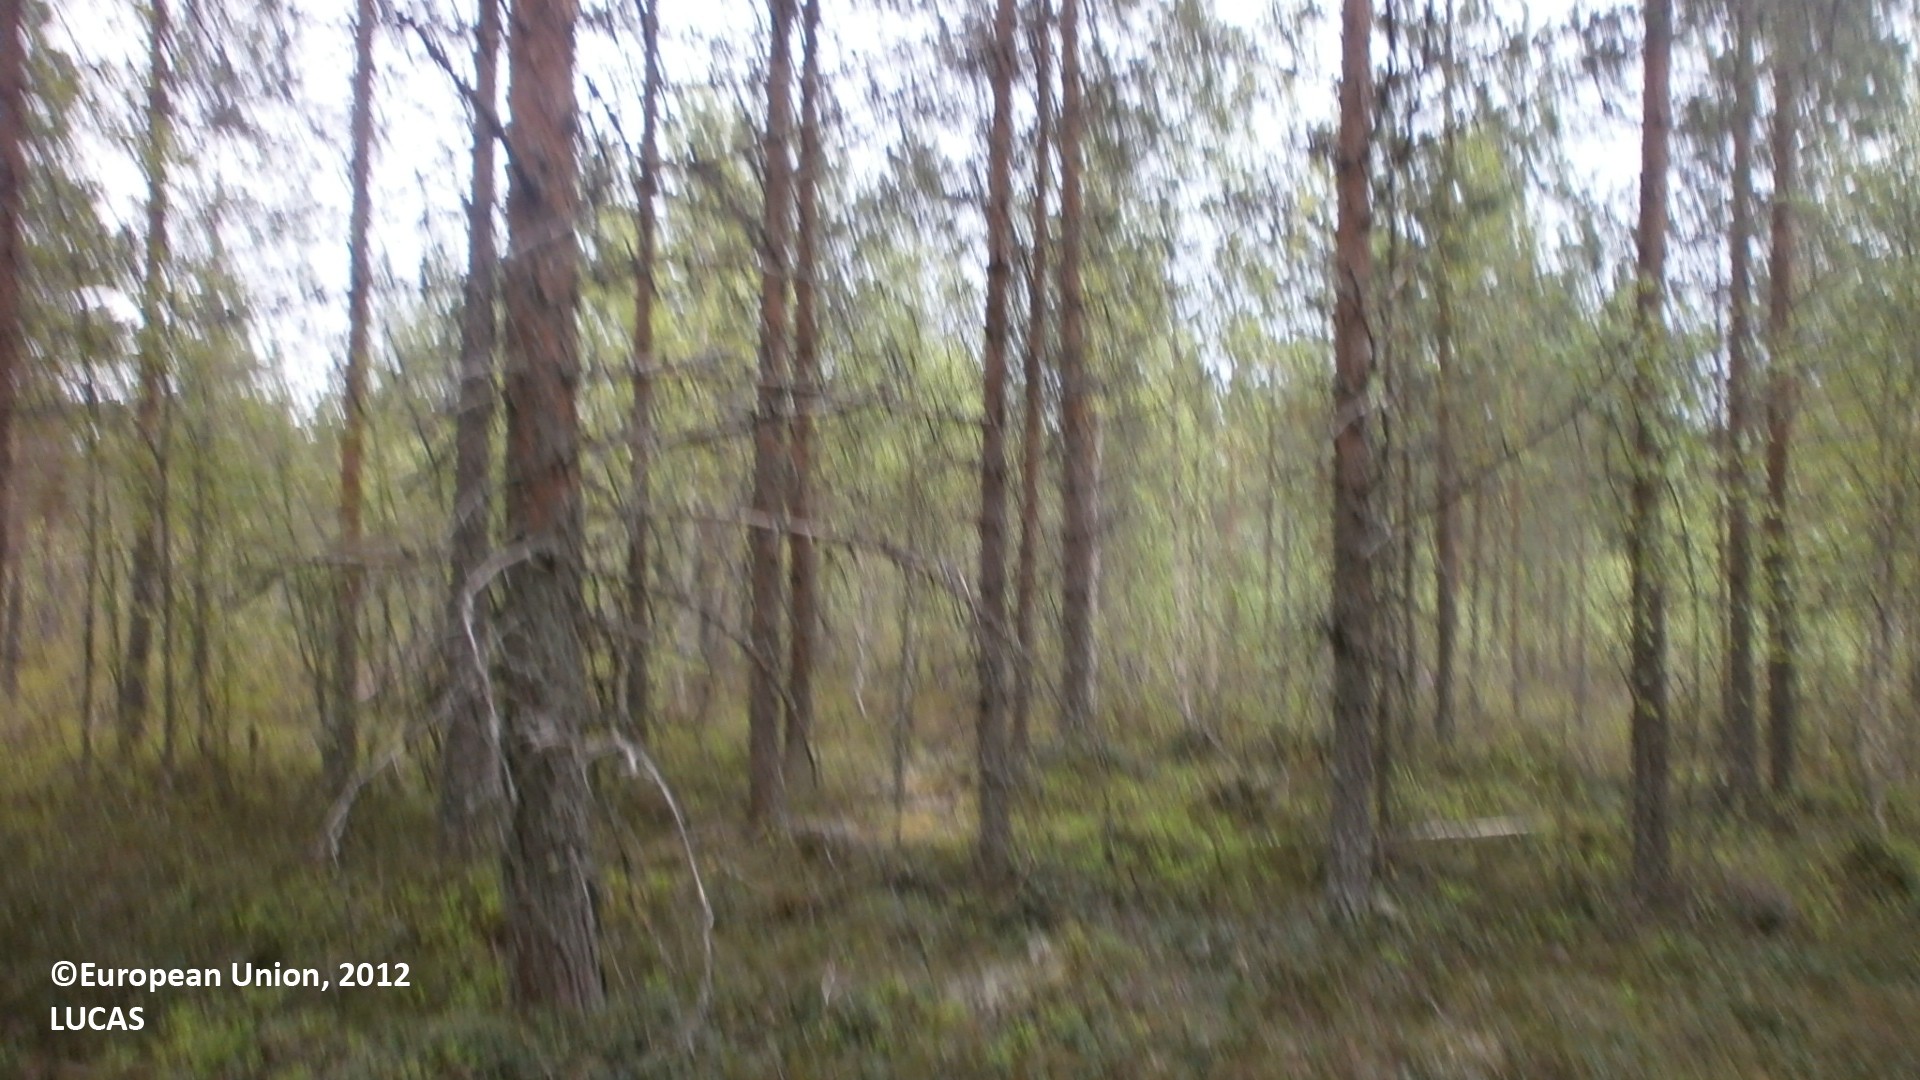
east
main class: Woodland
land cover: Pine dominated coniferous woodland
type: mire and swamp forests
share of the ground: 50 - 75 %
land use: Forestry
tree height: > 5 m
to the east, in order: Pine dominated coniferous woodland; Broadleaved woodland; Ditches and canals; Spontaneously vegetated surfaces; Electric lines; Spontaneously vegetated surfaces; Pine dominated coniferous woodland; Shrubland with sparse tree cover; Ditches and canals; Shruby margins; Paved roads, cycling and walking lanes; Shruby margins; Ditches and canals; Shruby margins; Pine dominated mixed woodland; Pine dominated coniferous woodland
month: June
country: FI
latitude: 64.3883
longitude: 25.1149
